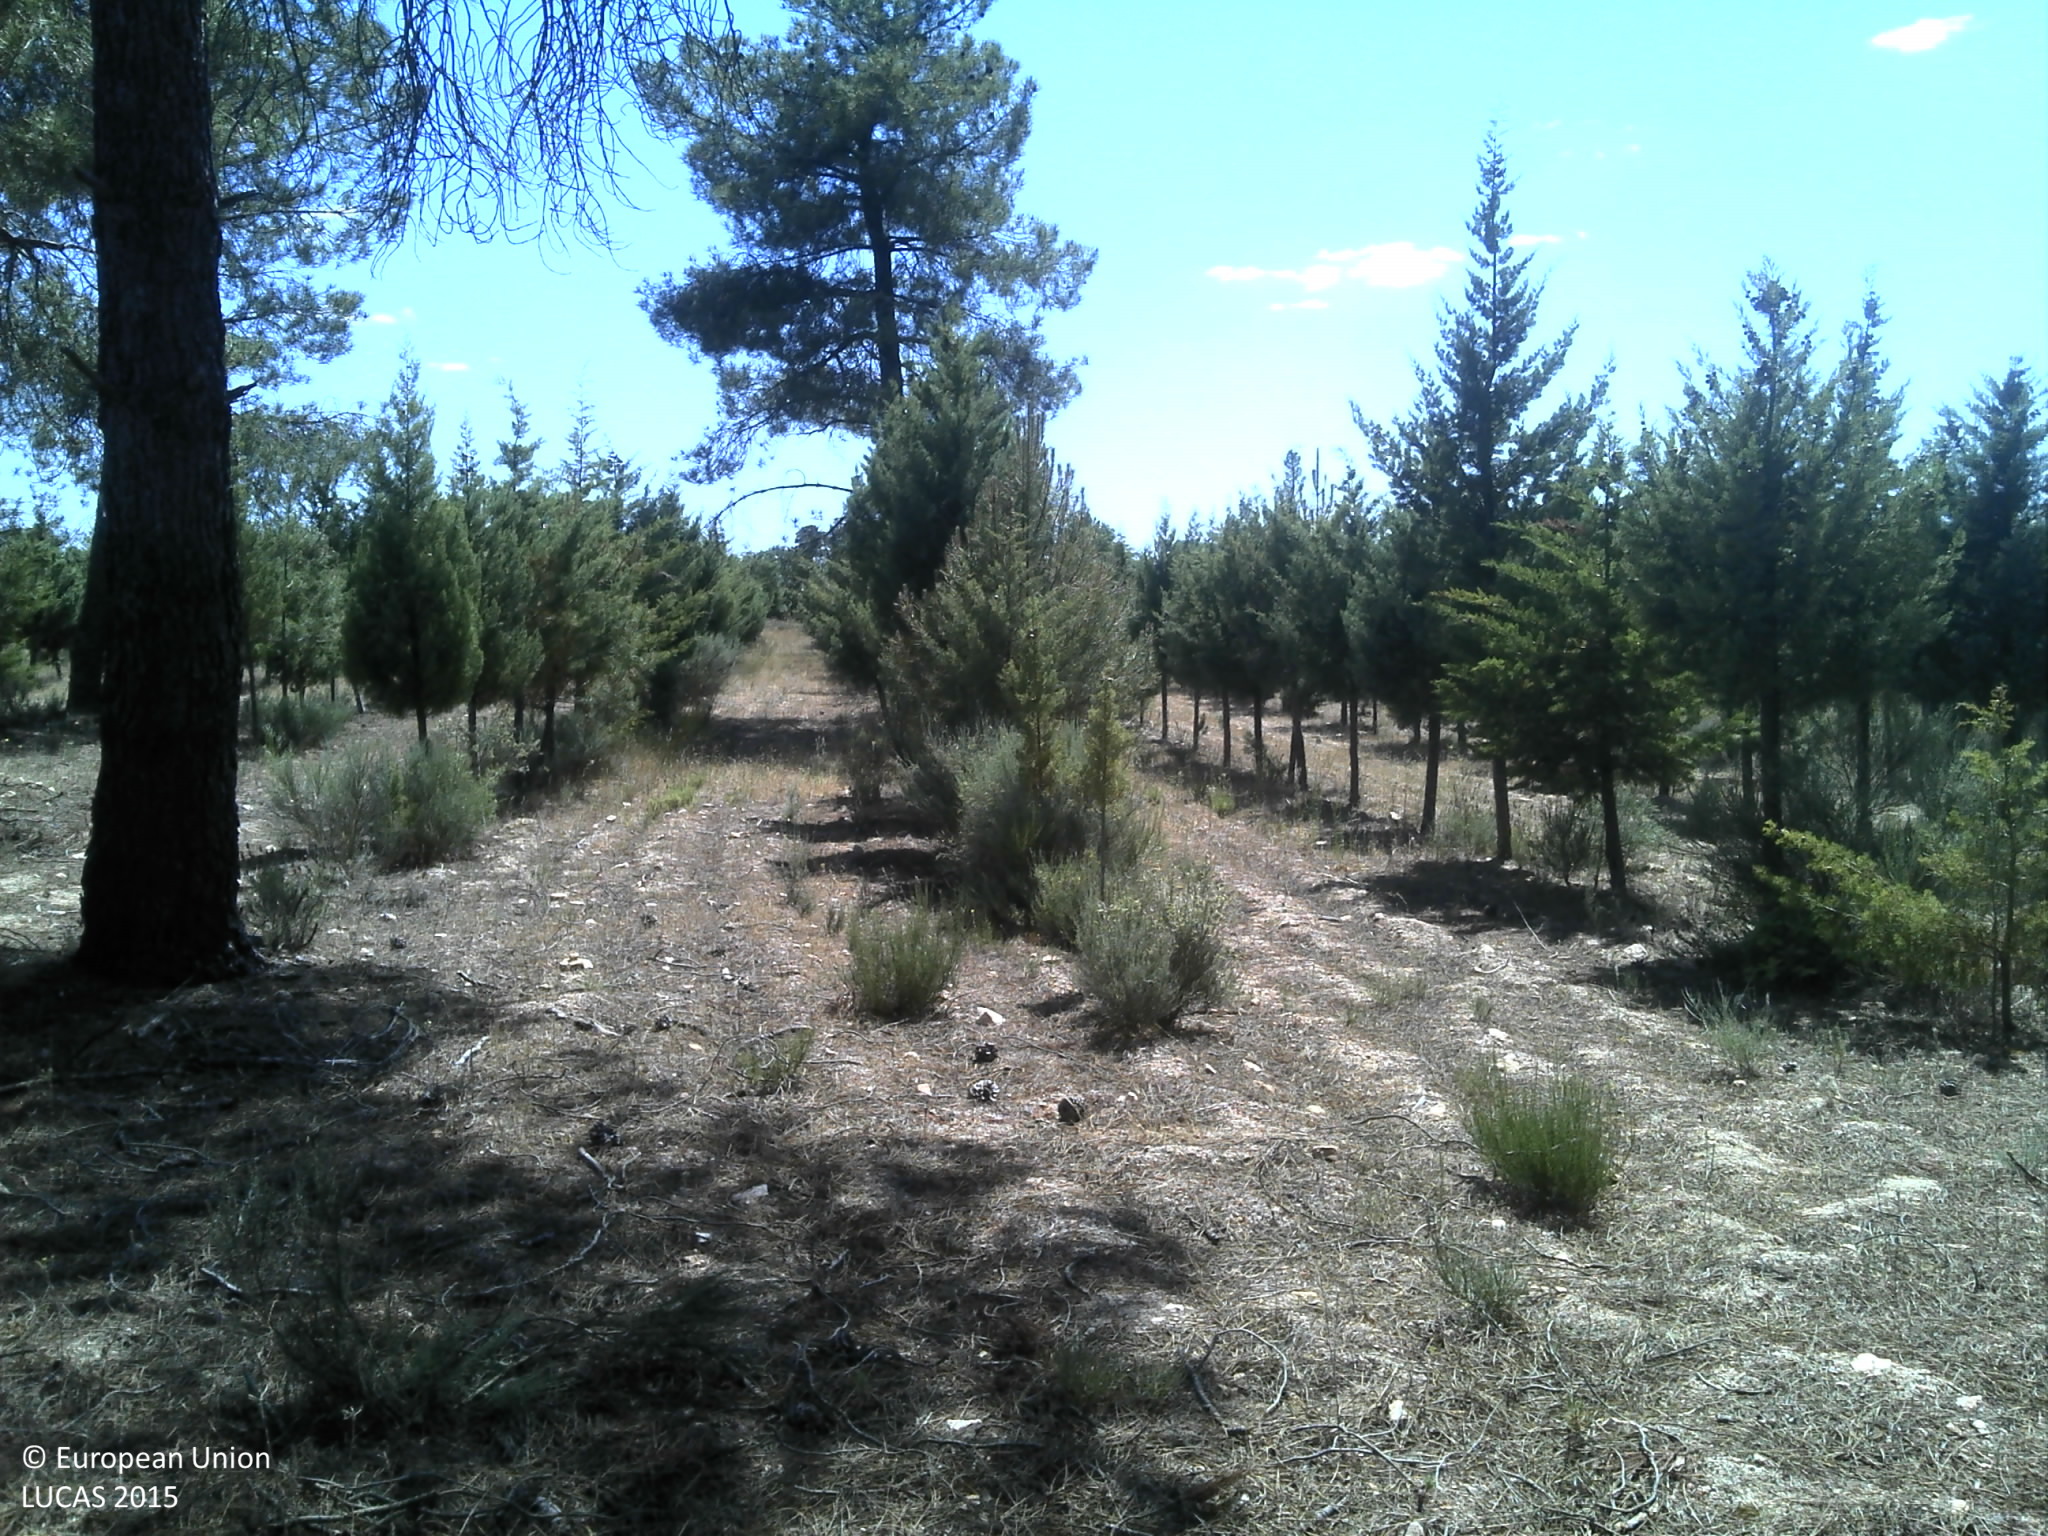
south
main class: Woodland
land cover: Pine dominated coniferous woodland
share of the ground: 50 - 75 %
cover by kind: coniferous forest trees 70 %, unconsolidated bare surface 20 %, shrubs 5 %, herbaceous plants 5 %
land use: Forestry
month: June
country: PT
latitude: 40.7109
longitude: -6.8722
